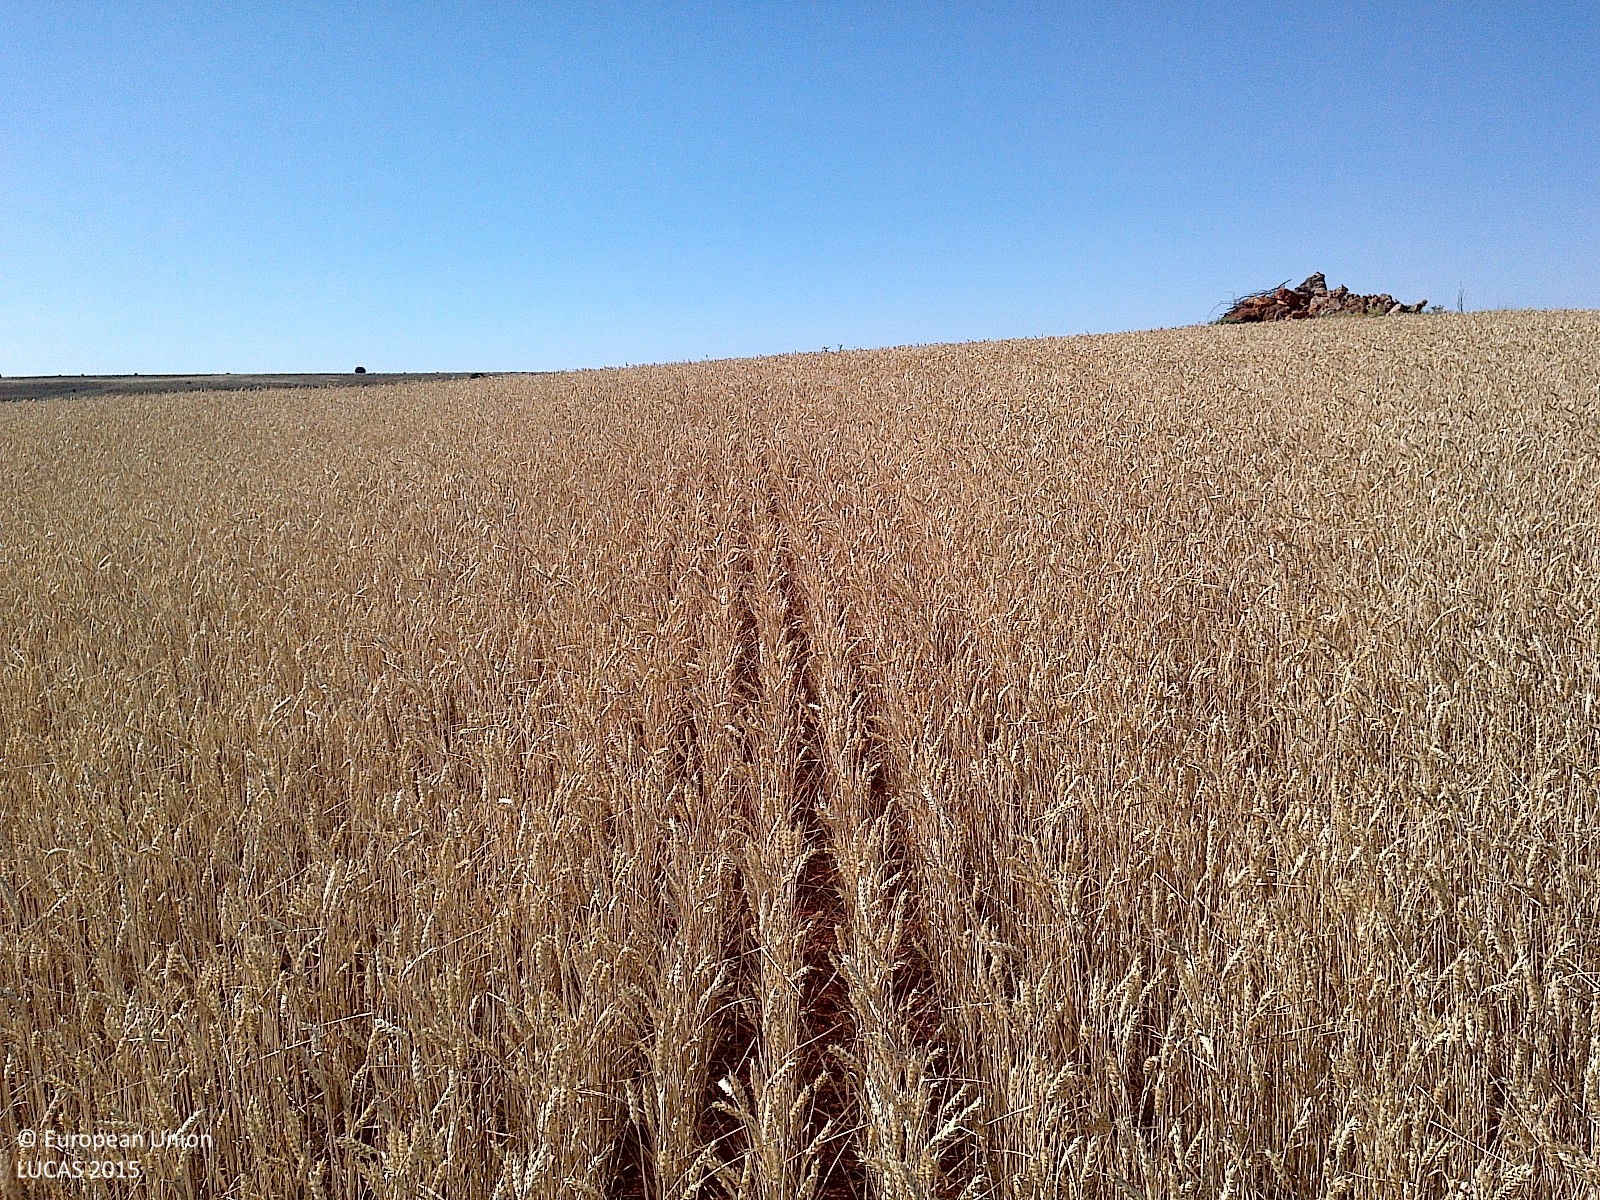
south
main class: Cropland
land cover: Common wheat
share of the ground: > 75 %
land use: Agriculture (excluding fallow land and kitchen gardens)
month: July
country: ES
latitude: 41.6579
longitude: -2.7818
